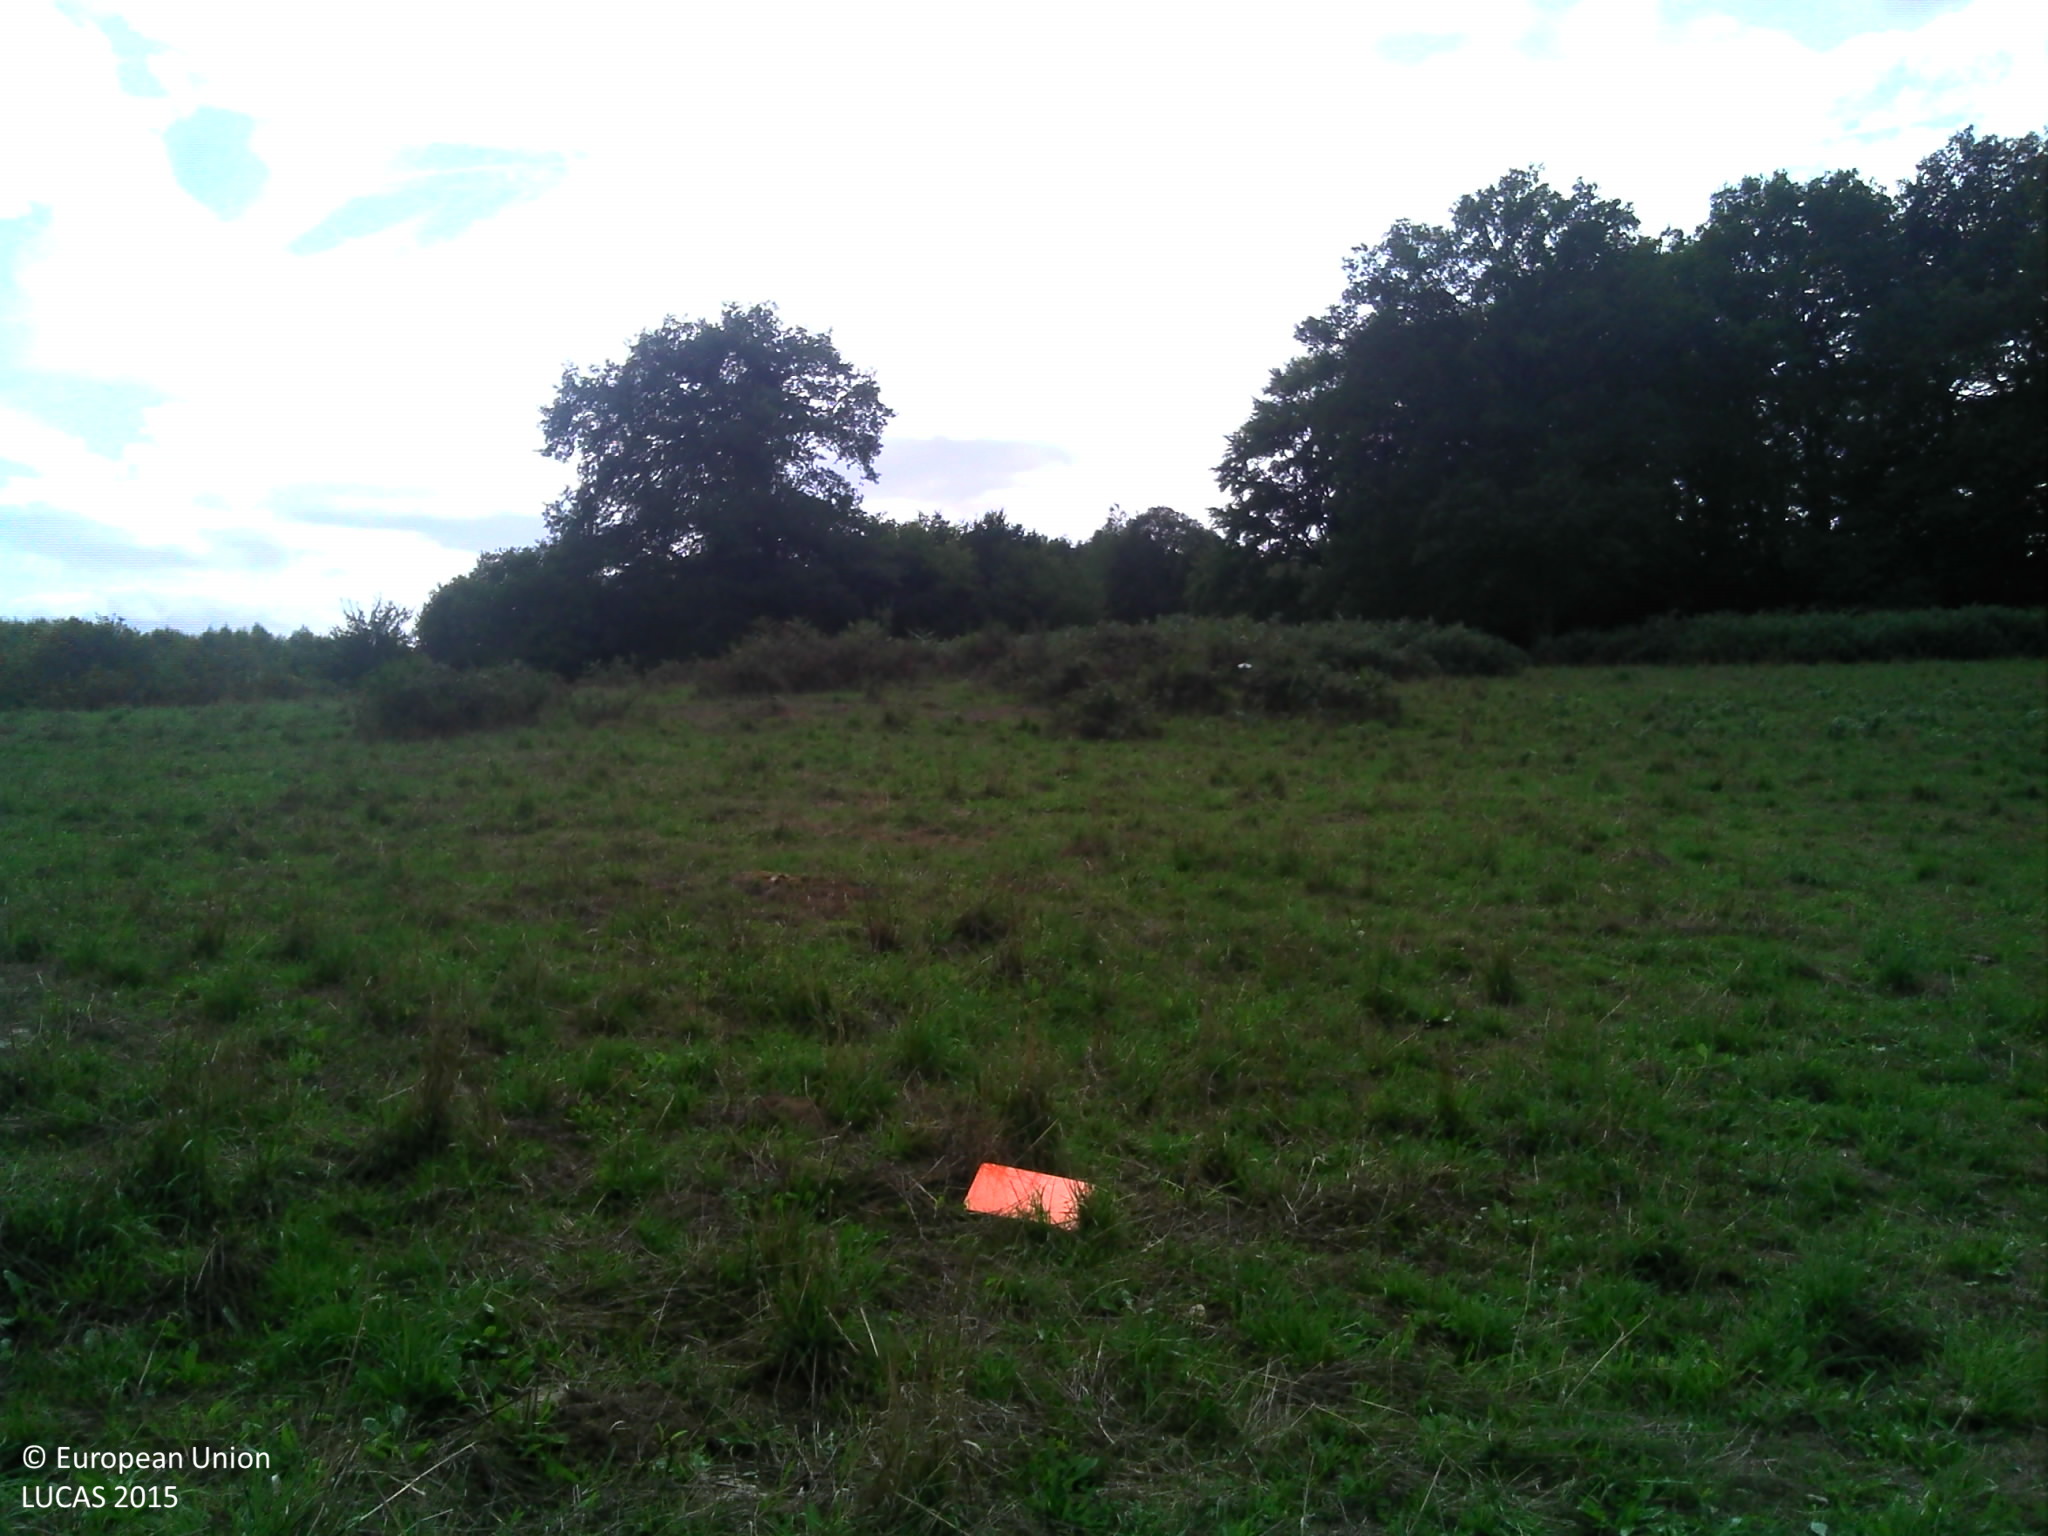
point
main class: Grassland
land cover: Grassland without tree/shrub cover
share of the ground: > 75 %
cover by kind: herbaceous plants 95 %, shrubs 5 %
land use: Agriculture (excluding fallow land and kitchen gardens)
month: August
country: FR
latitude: 45.9963
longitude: 2.2357
